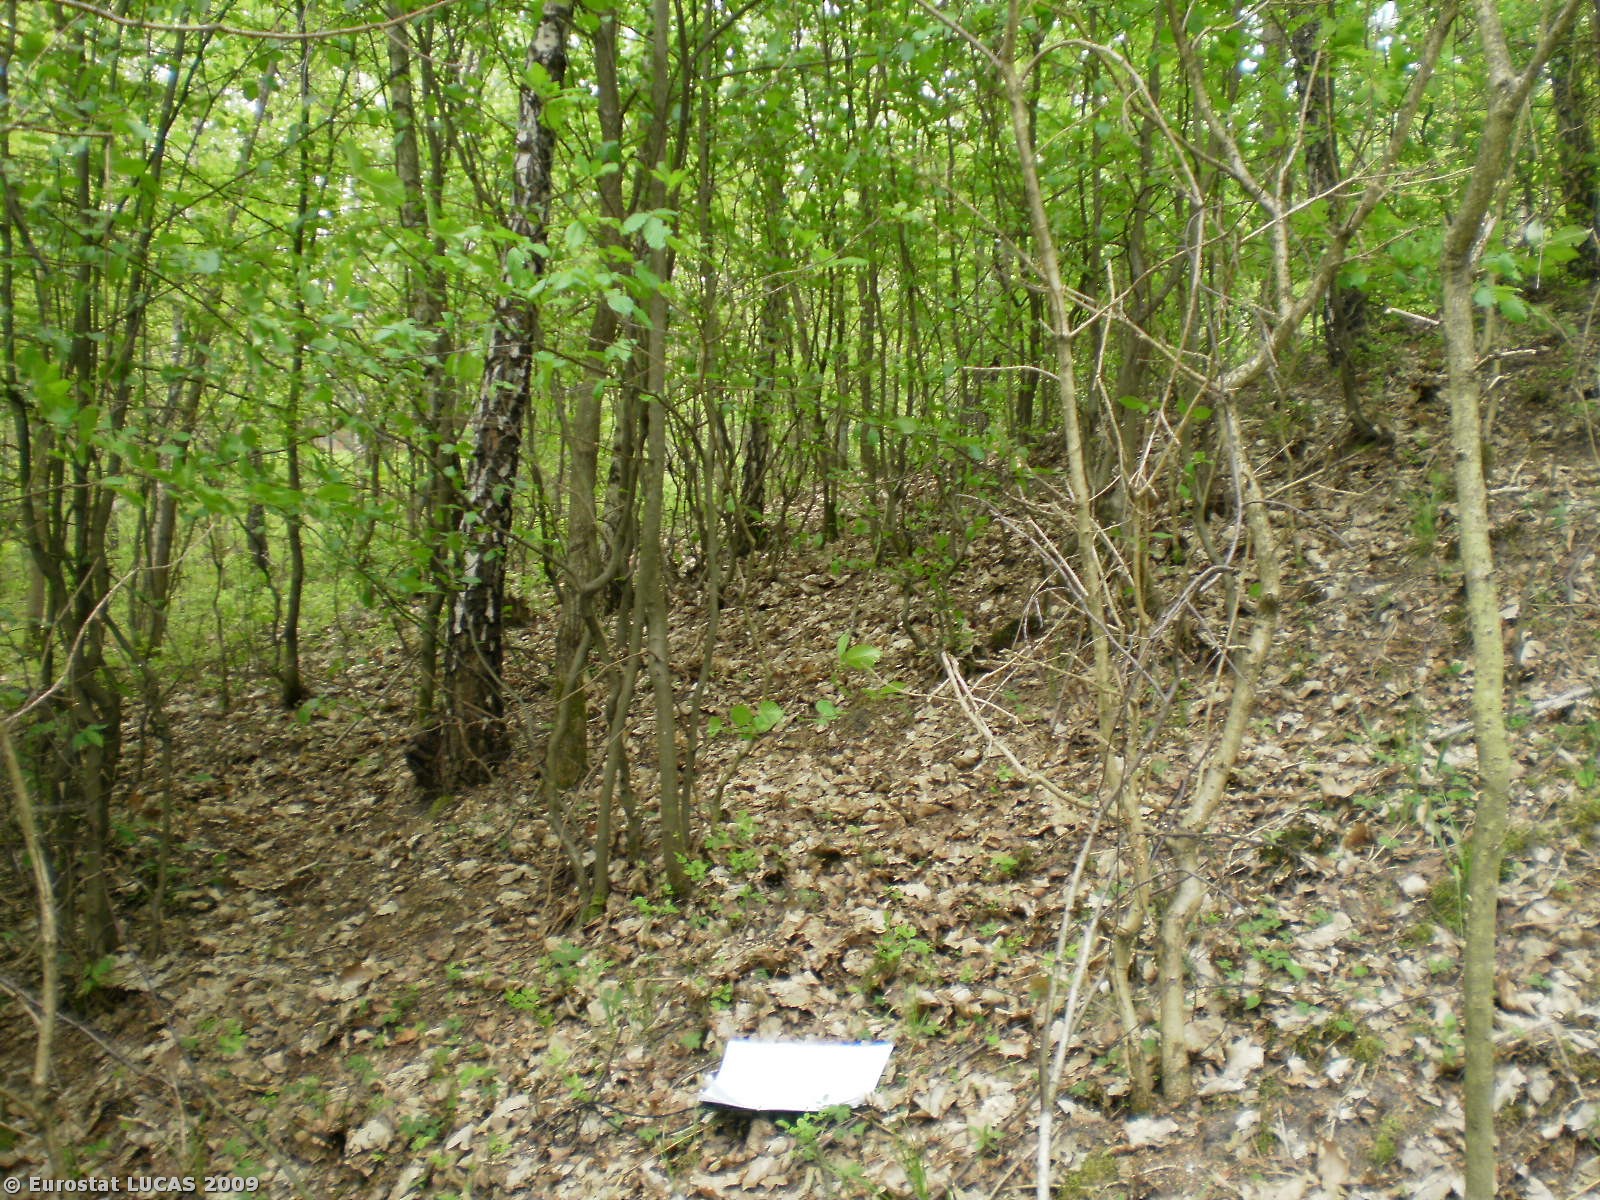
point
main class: Woodland
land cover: Broadleaved woodland
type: mesophytic deciduous forest
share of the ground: > 75 %
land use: Forestry
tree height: > 5 m
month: May
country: PL
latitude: 53.6190
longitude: 18.8649
